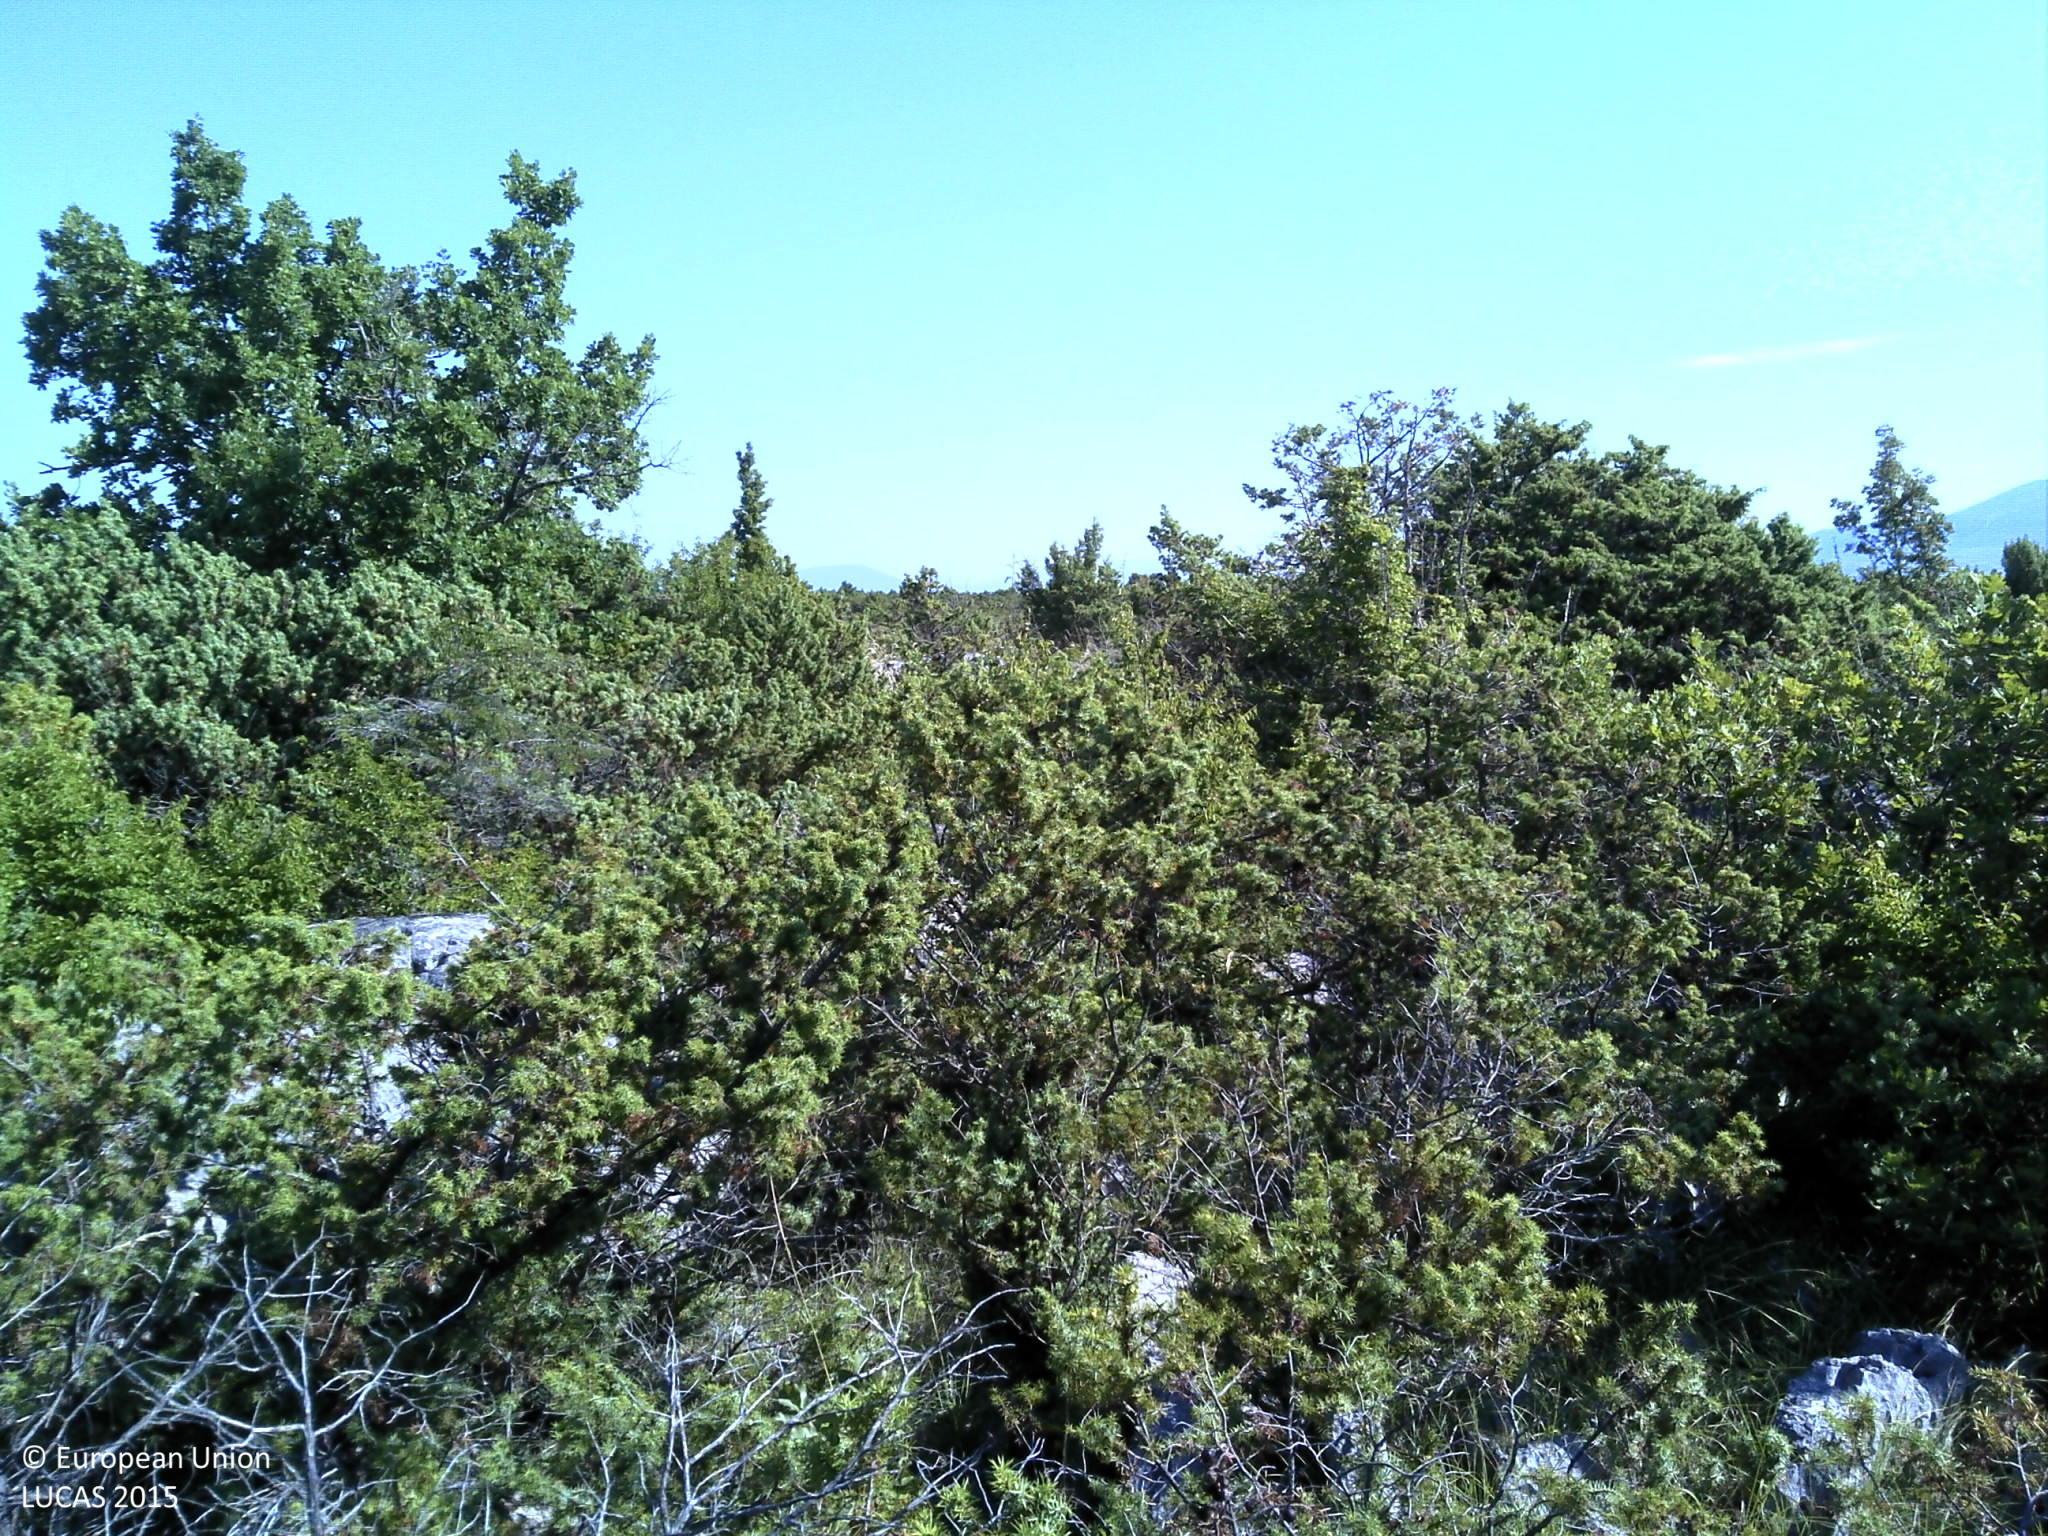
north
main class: Shrubland
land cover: Shrubland with sparse tree cover
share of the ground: > 75 %
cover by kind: shrubs 75 %, consolidated bare surface 20 %, broadleaved forest trees 5 %
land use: Semi-natural and natural areas not in use
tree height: > 5 m
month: July
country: HR
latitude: 43.8291
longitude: 16.0724
